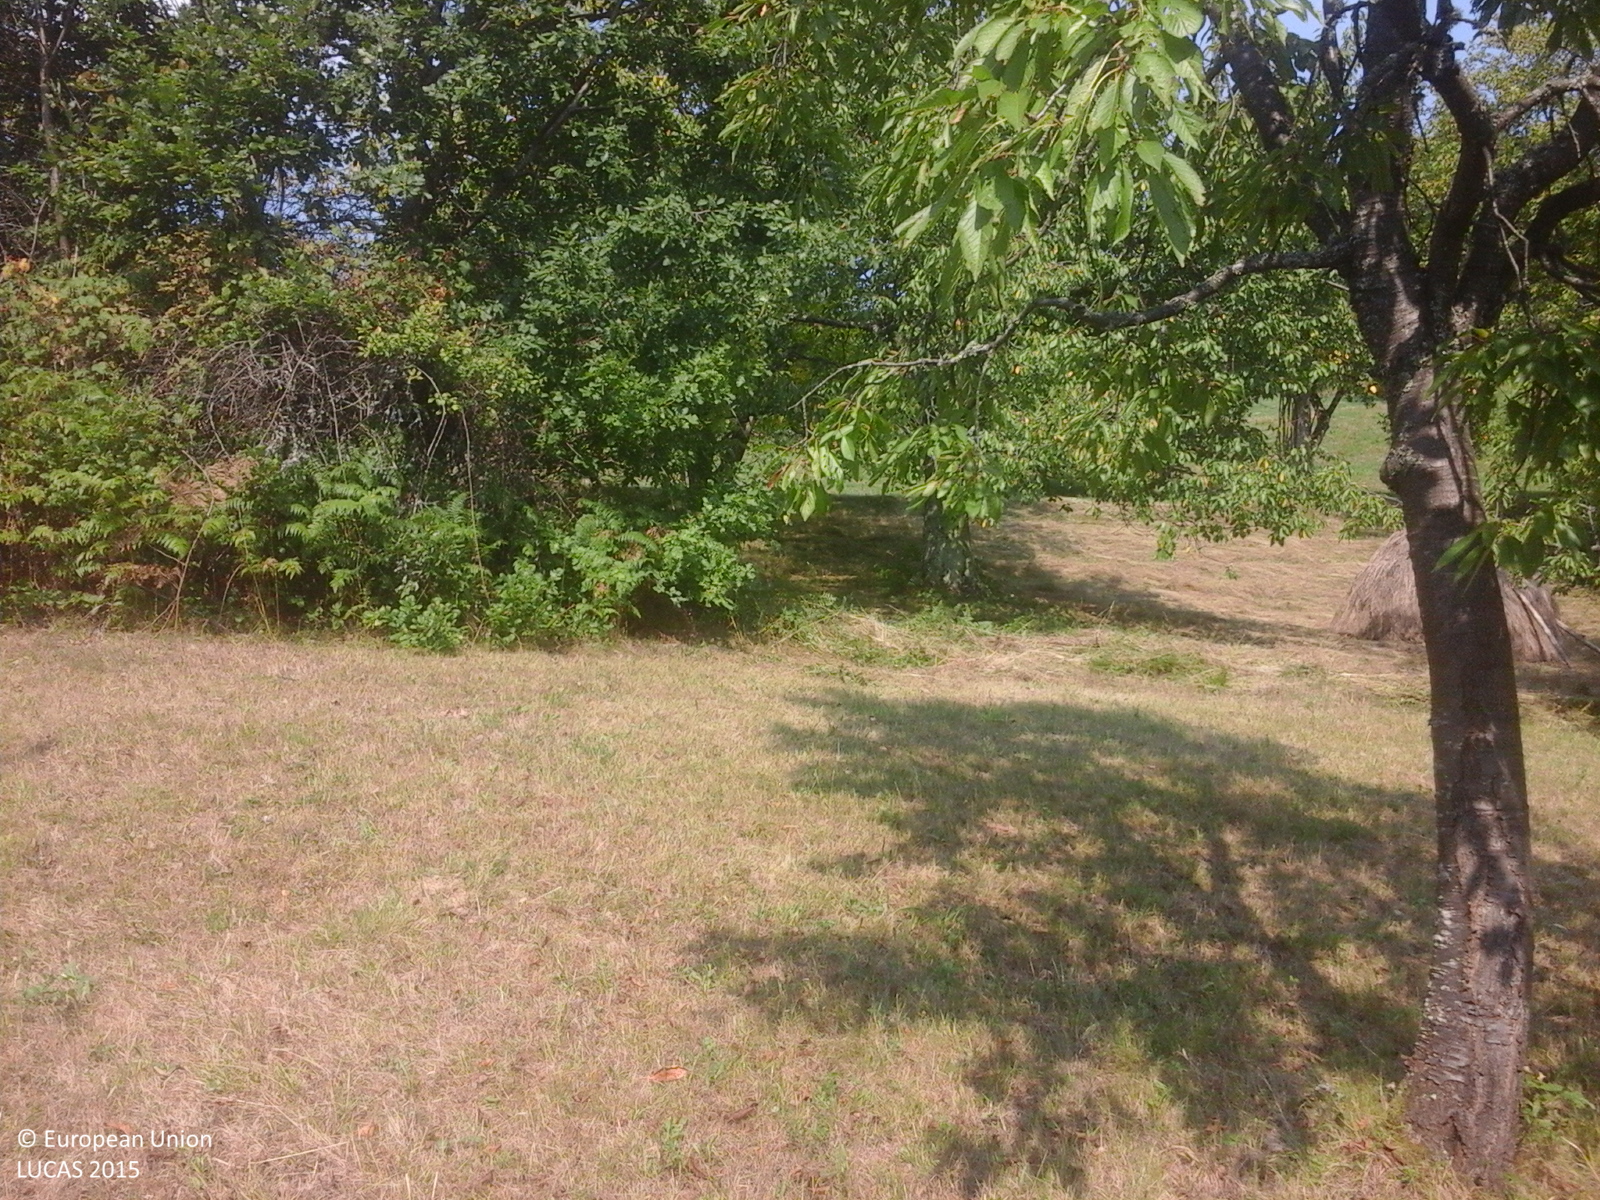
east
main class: Grassland
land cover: Grassland without tree/shrub cover
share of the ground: > 75 %
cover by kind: herbaceous plants 100 %
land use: Agriculture (excluding fallow land and kitchen gardens)
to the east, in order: Grassland without tree/shrub cover; Broadleaved woodland; Other fruit trees and berries; Grassland without tree/shrub cover
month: August
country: RO
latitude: 46.3507
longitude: 22.5919
